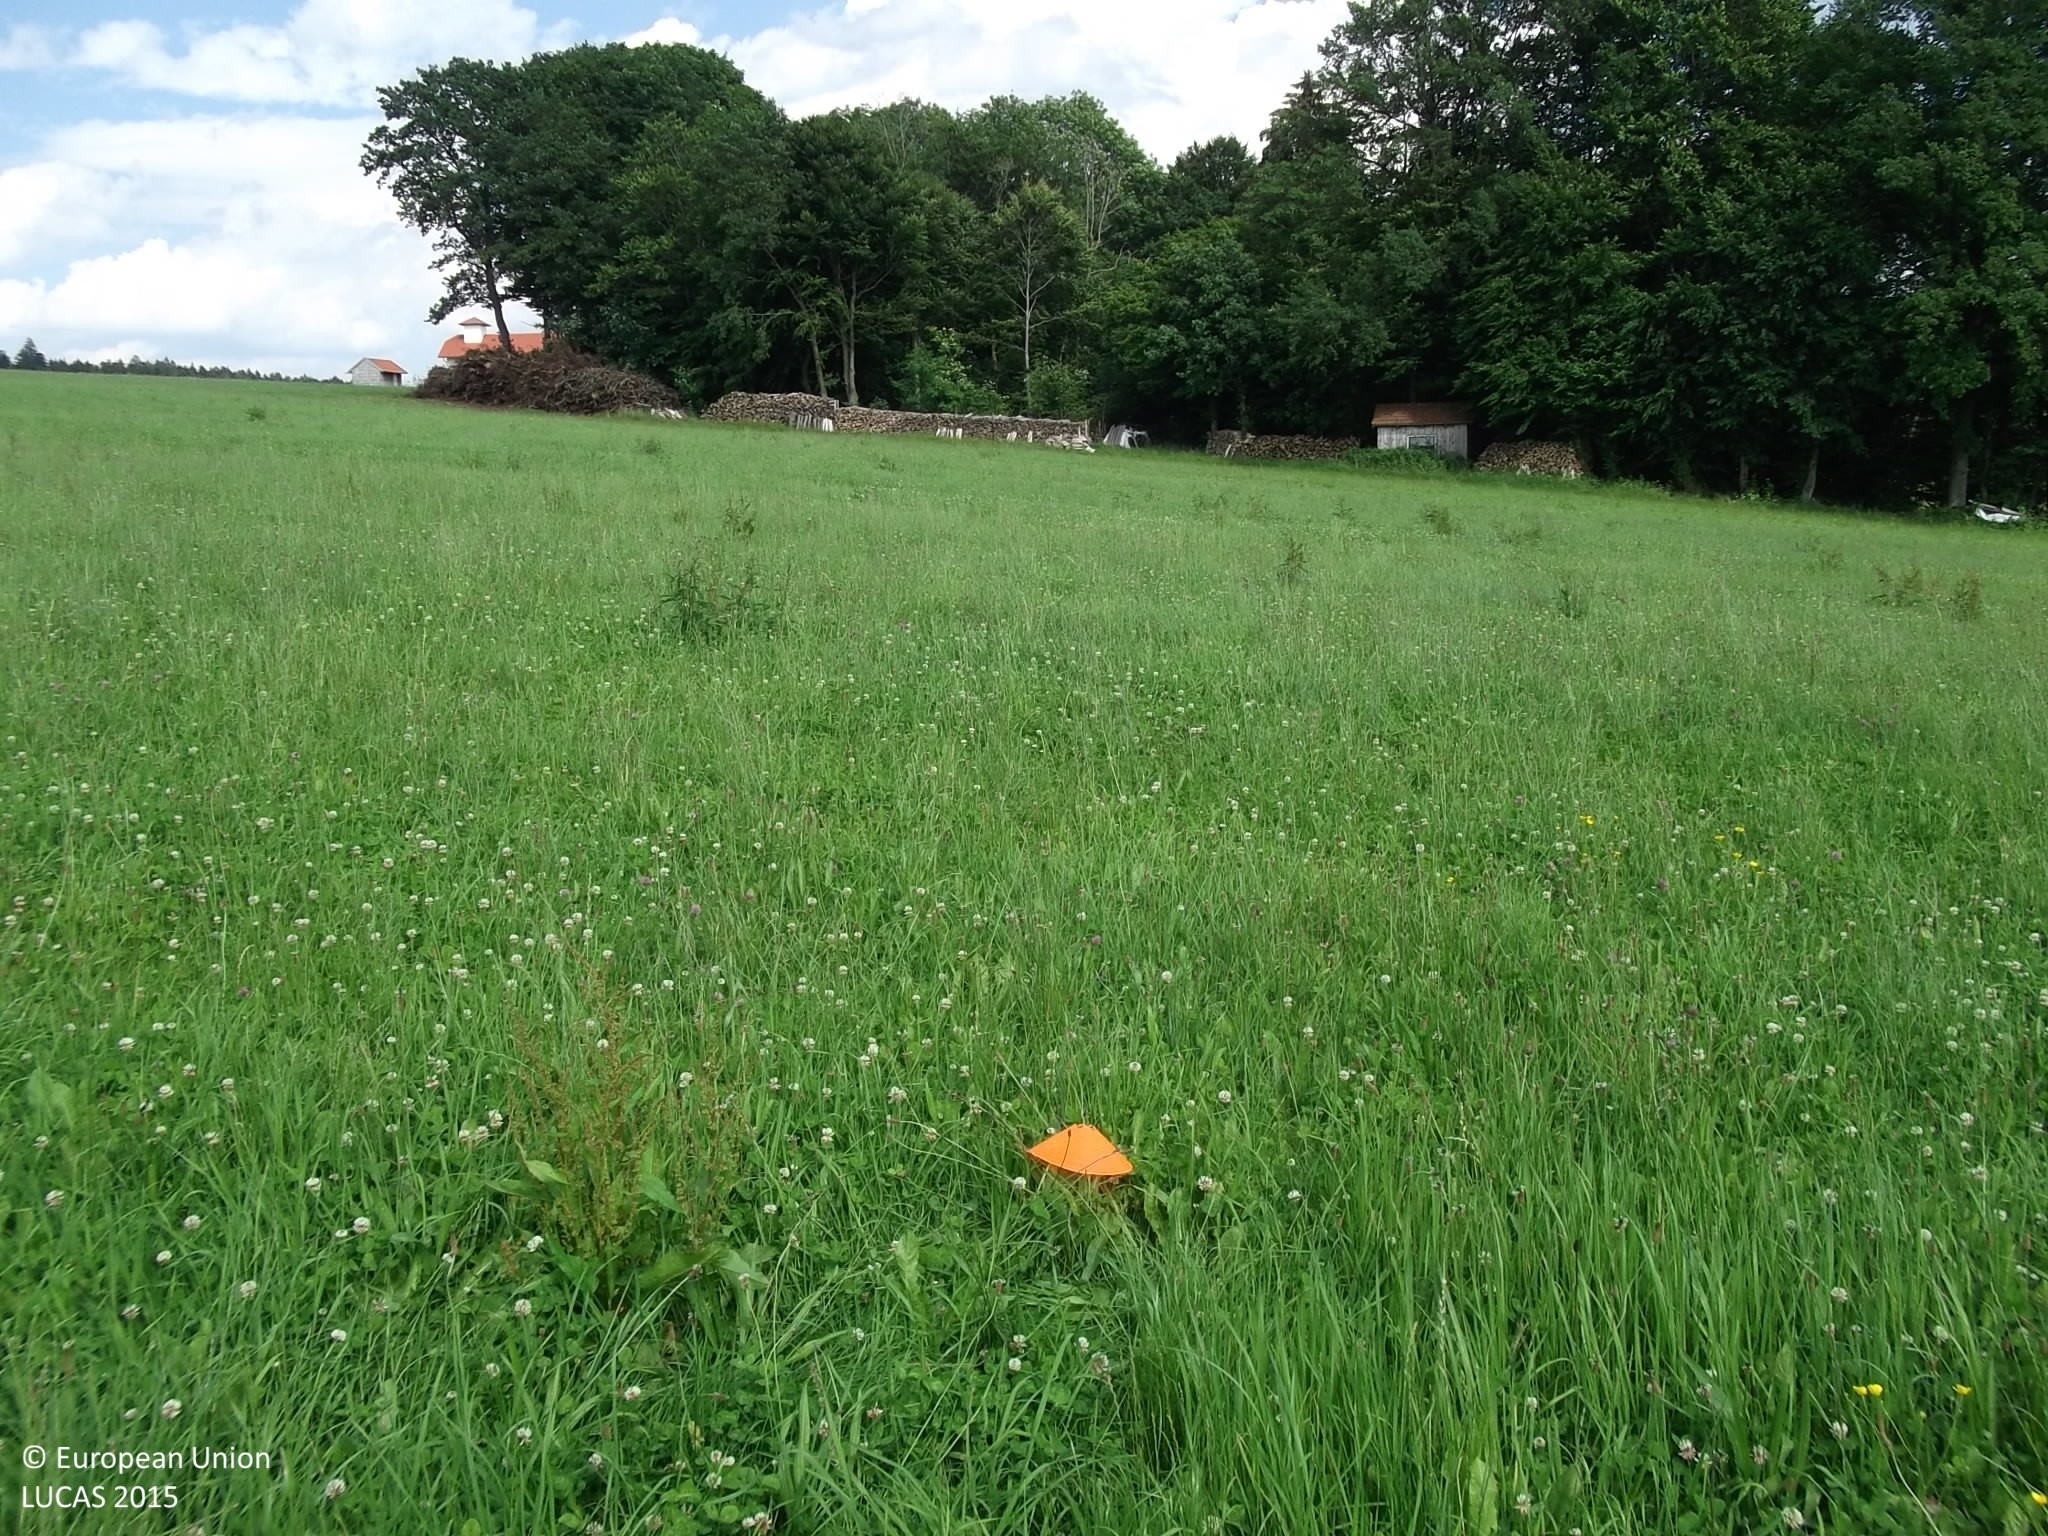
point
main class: Grassland
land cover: Grassland without tree/shrub cover
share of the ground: > 75 %
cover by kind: herbaceous plants 100 %
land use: Agriculture (excluding fallow land and kitchen gardens)
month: June
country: AT
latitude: 48.0110
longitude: 13.3369
